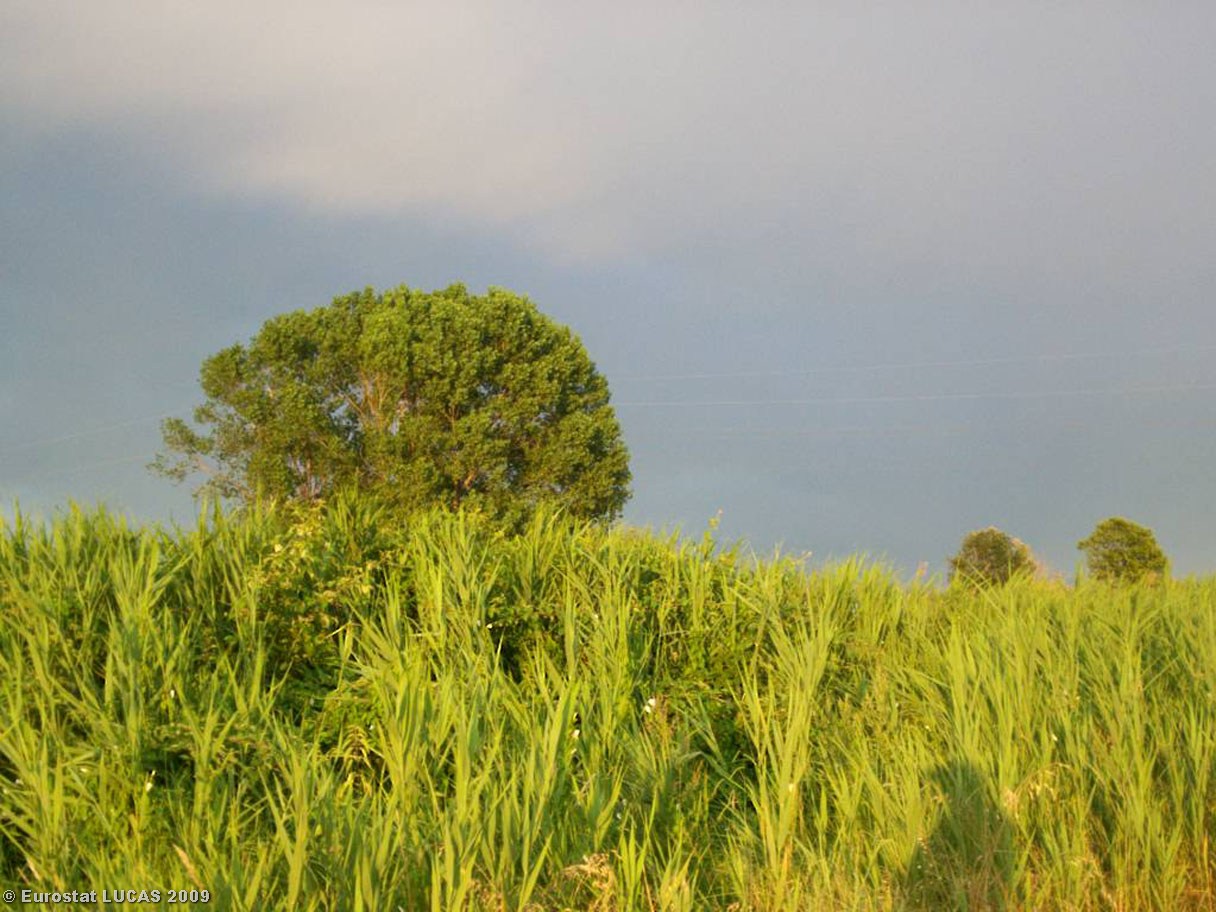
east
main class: Grassland
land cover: Spontaneously vegetated surfaces
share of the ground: > 75 %
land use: Fallow land
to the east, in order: Spontaneously vegetated surfaces; Tracks; Spontaneously vegetated surfaces; Single bushes/trees; Spontaneously vegetated surfaces; Fences; Artificial constructions in urban areas
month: June
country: IT
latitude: 43.8812
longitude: 10.2607
